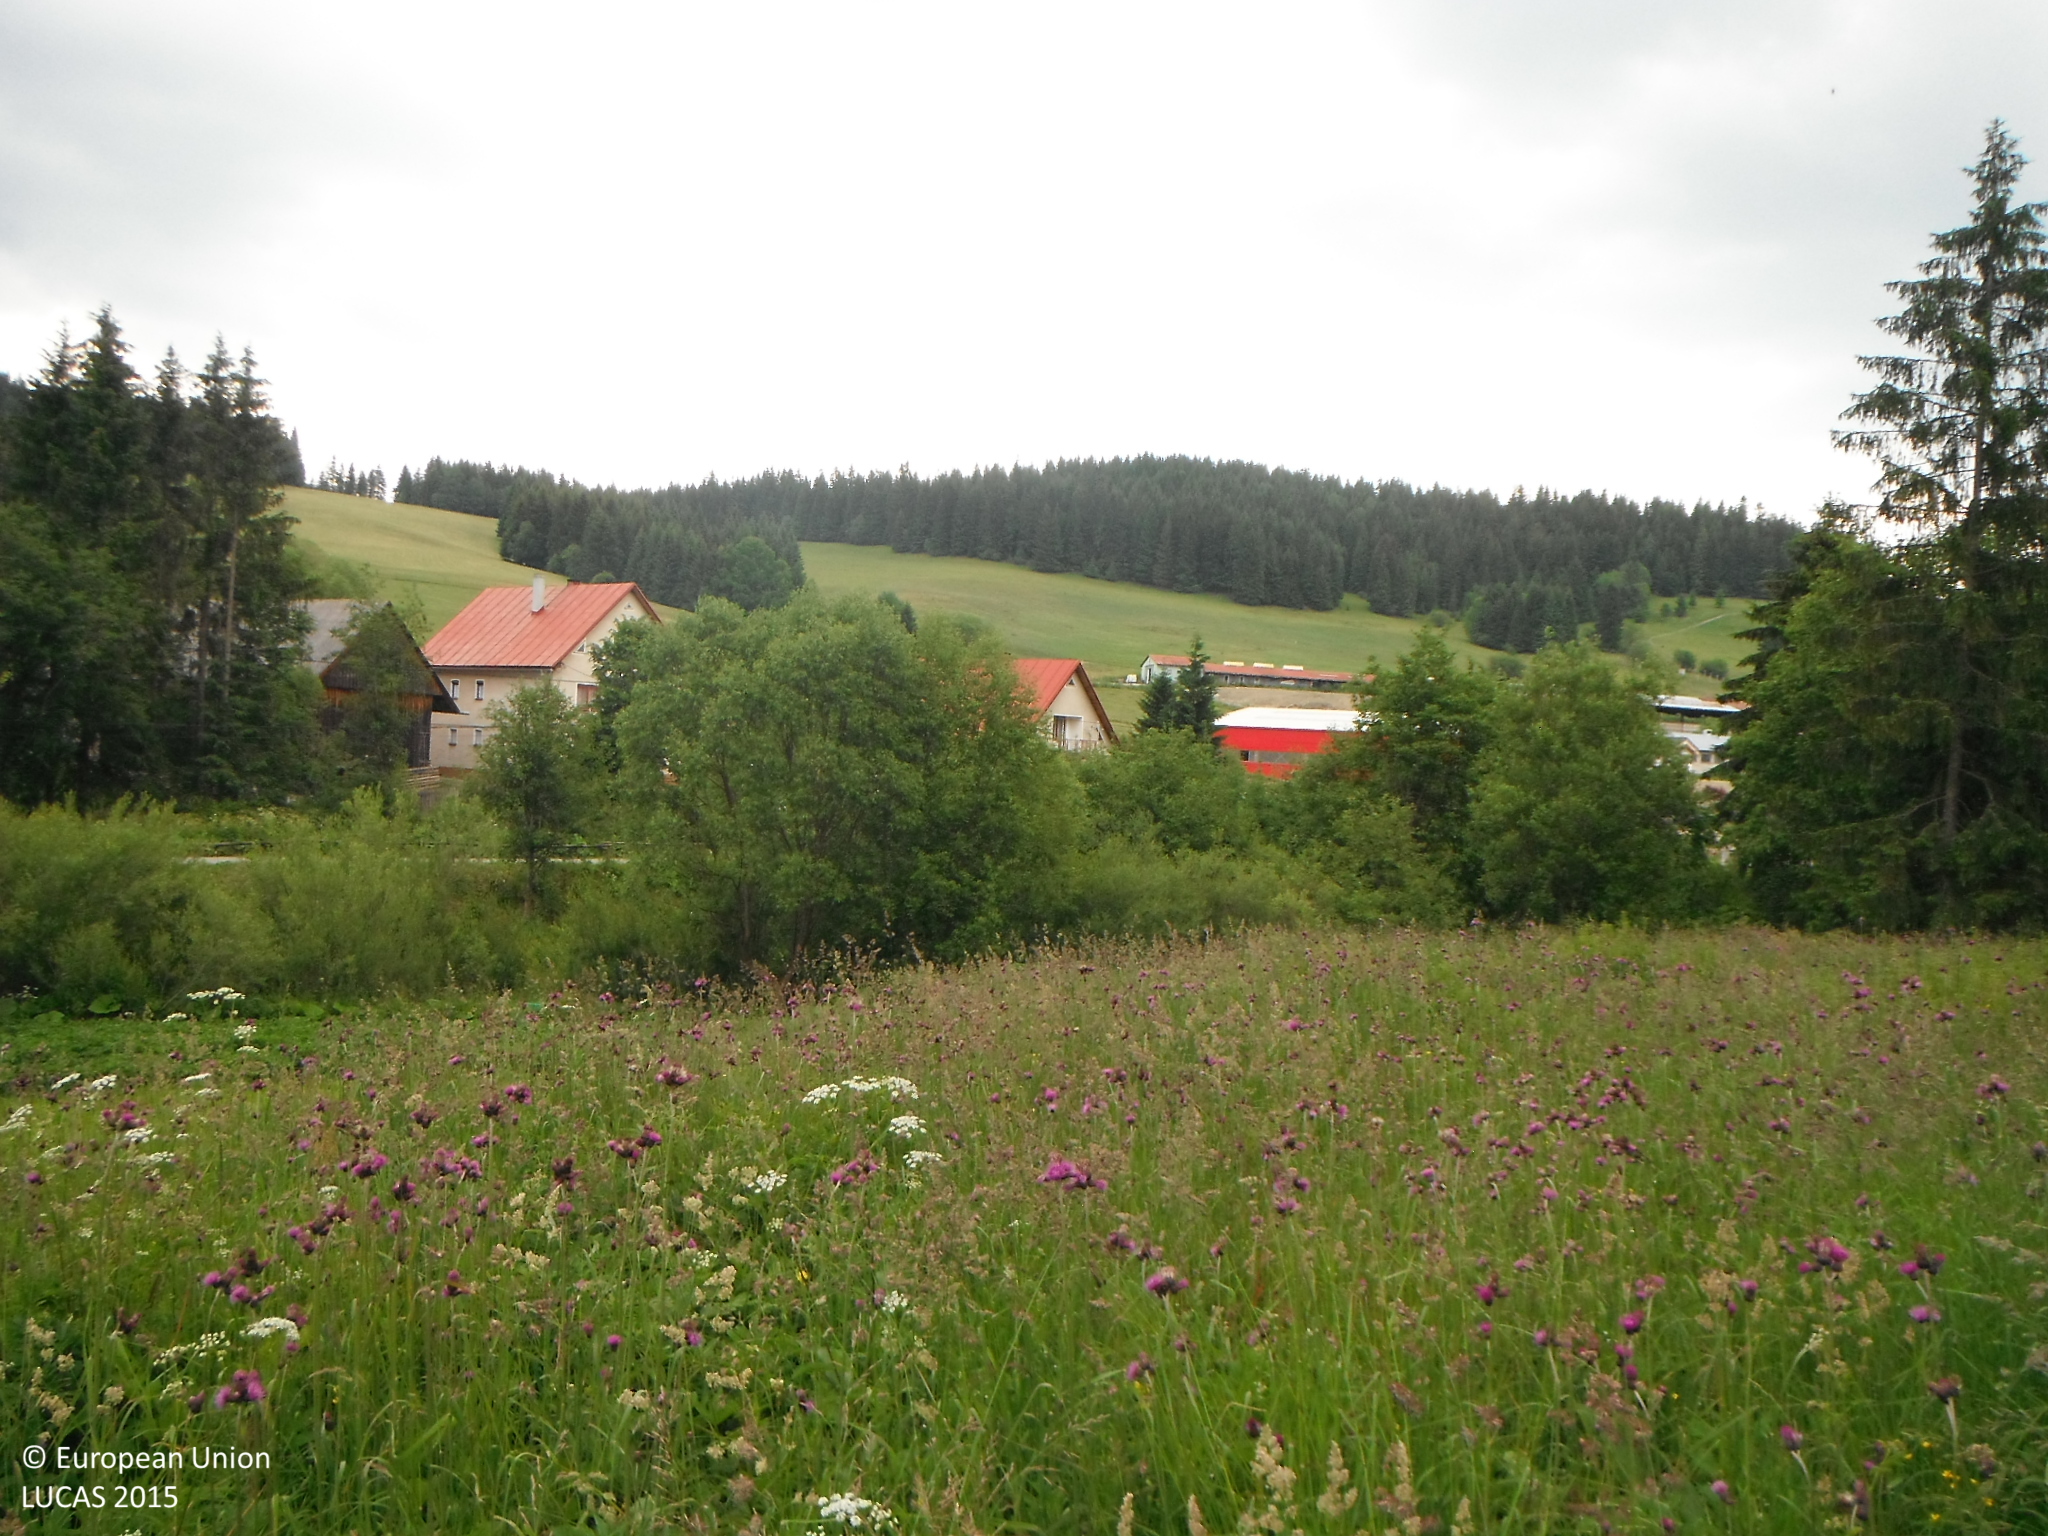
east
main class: Grassland
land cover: Spontaneously vegetated surfaces
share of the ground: > 75 %
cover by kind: herbaceous plants 100 %
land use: Semi-natural and natural areas not in use
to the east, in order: Spontaneously vegetated surfaces; Potatoes; Shrubland with sparse tree cover; Rivers and streams; Broadleaved woodland; Artificial constructions in urban areas; Grassland without tree/shrub cover; Tracks; Fences; Grassland without tree/shrub cover; Fences; Grassland without tree/shrub cover; Fences; Grassland without tree/shrub cover
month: July
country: SK
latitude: 49.4431
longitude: 19.2790
